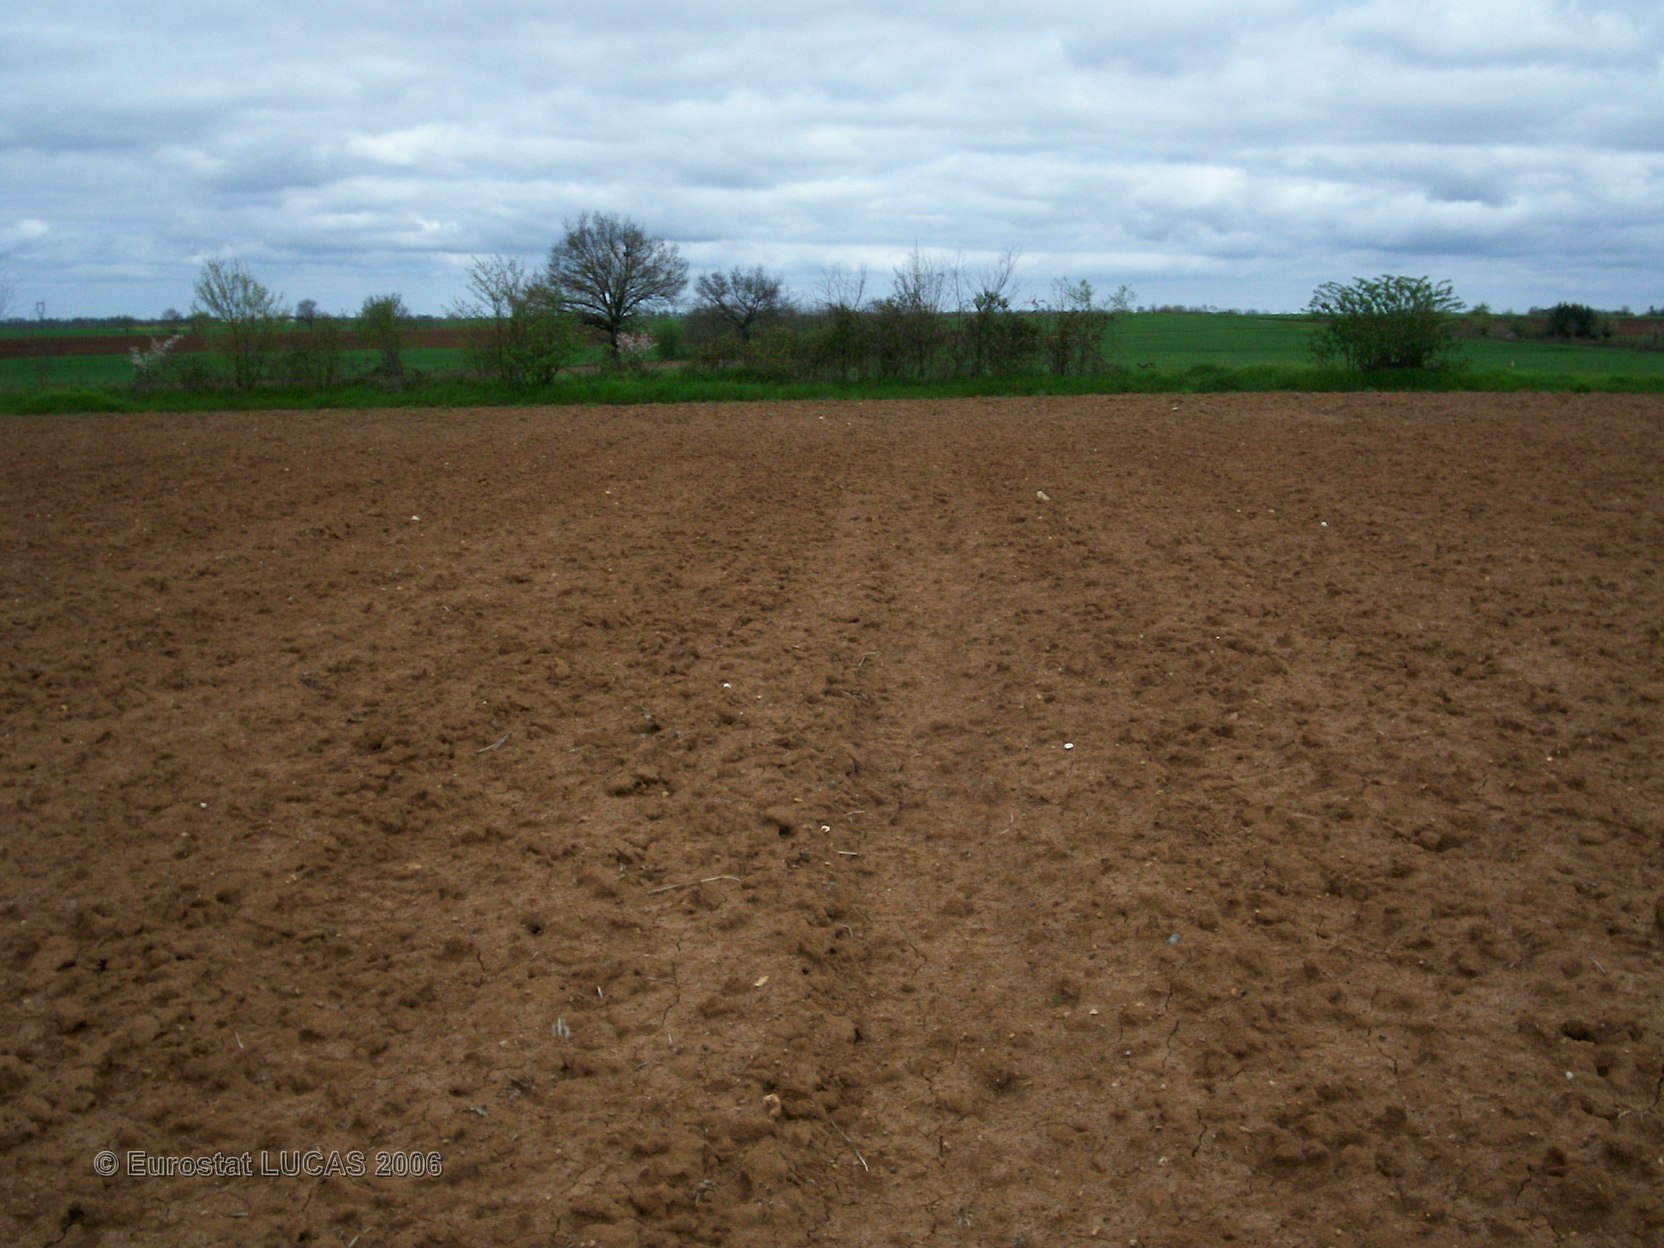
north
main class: Cropland
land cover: Maize
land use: Agriculture (excluding fallow land and kitchen gardens)
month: May
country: FR
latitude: 46.2916
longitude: -0.2651
